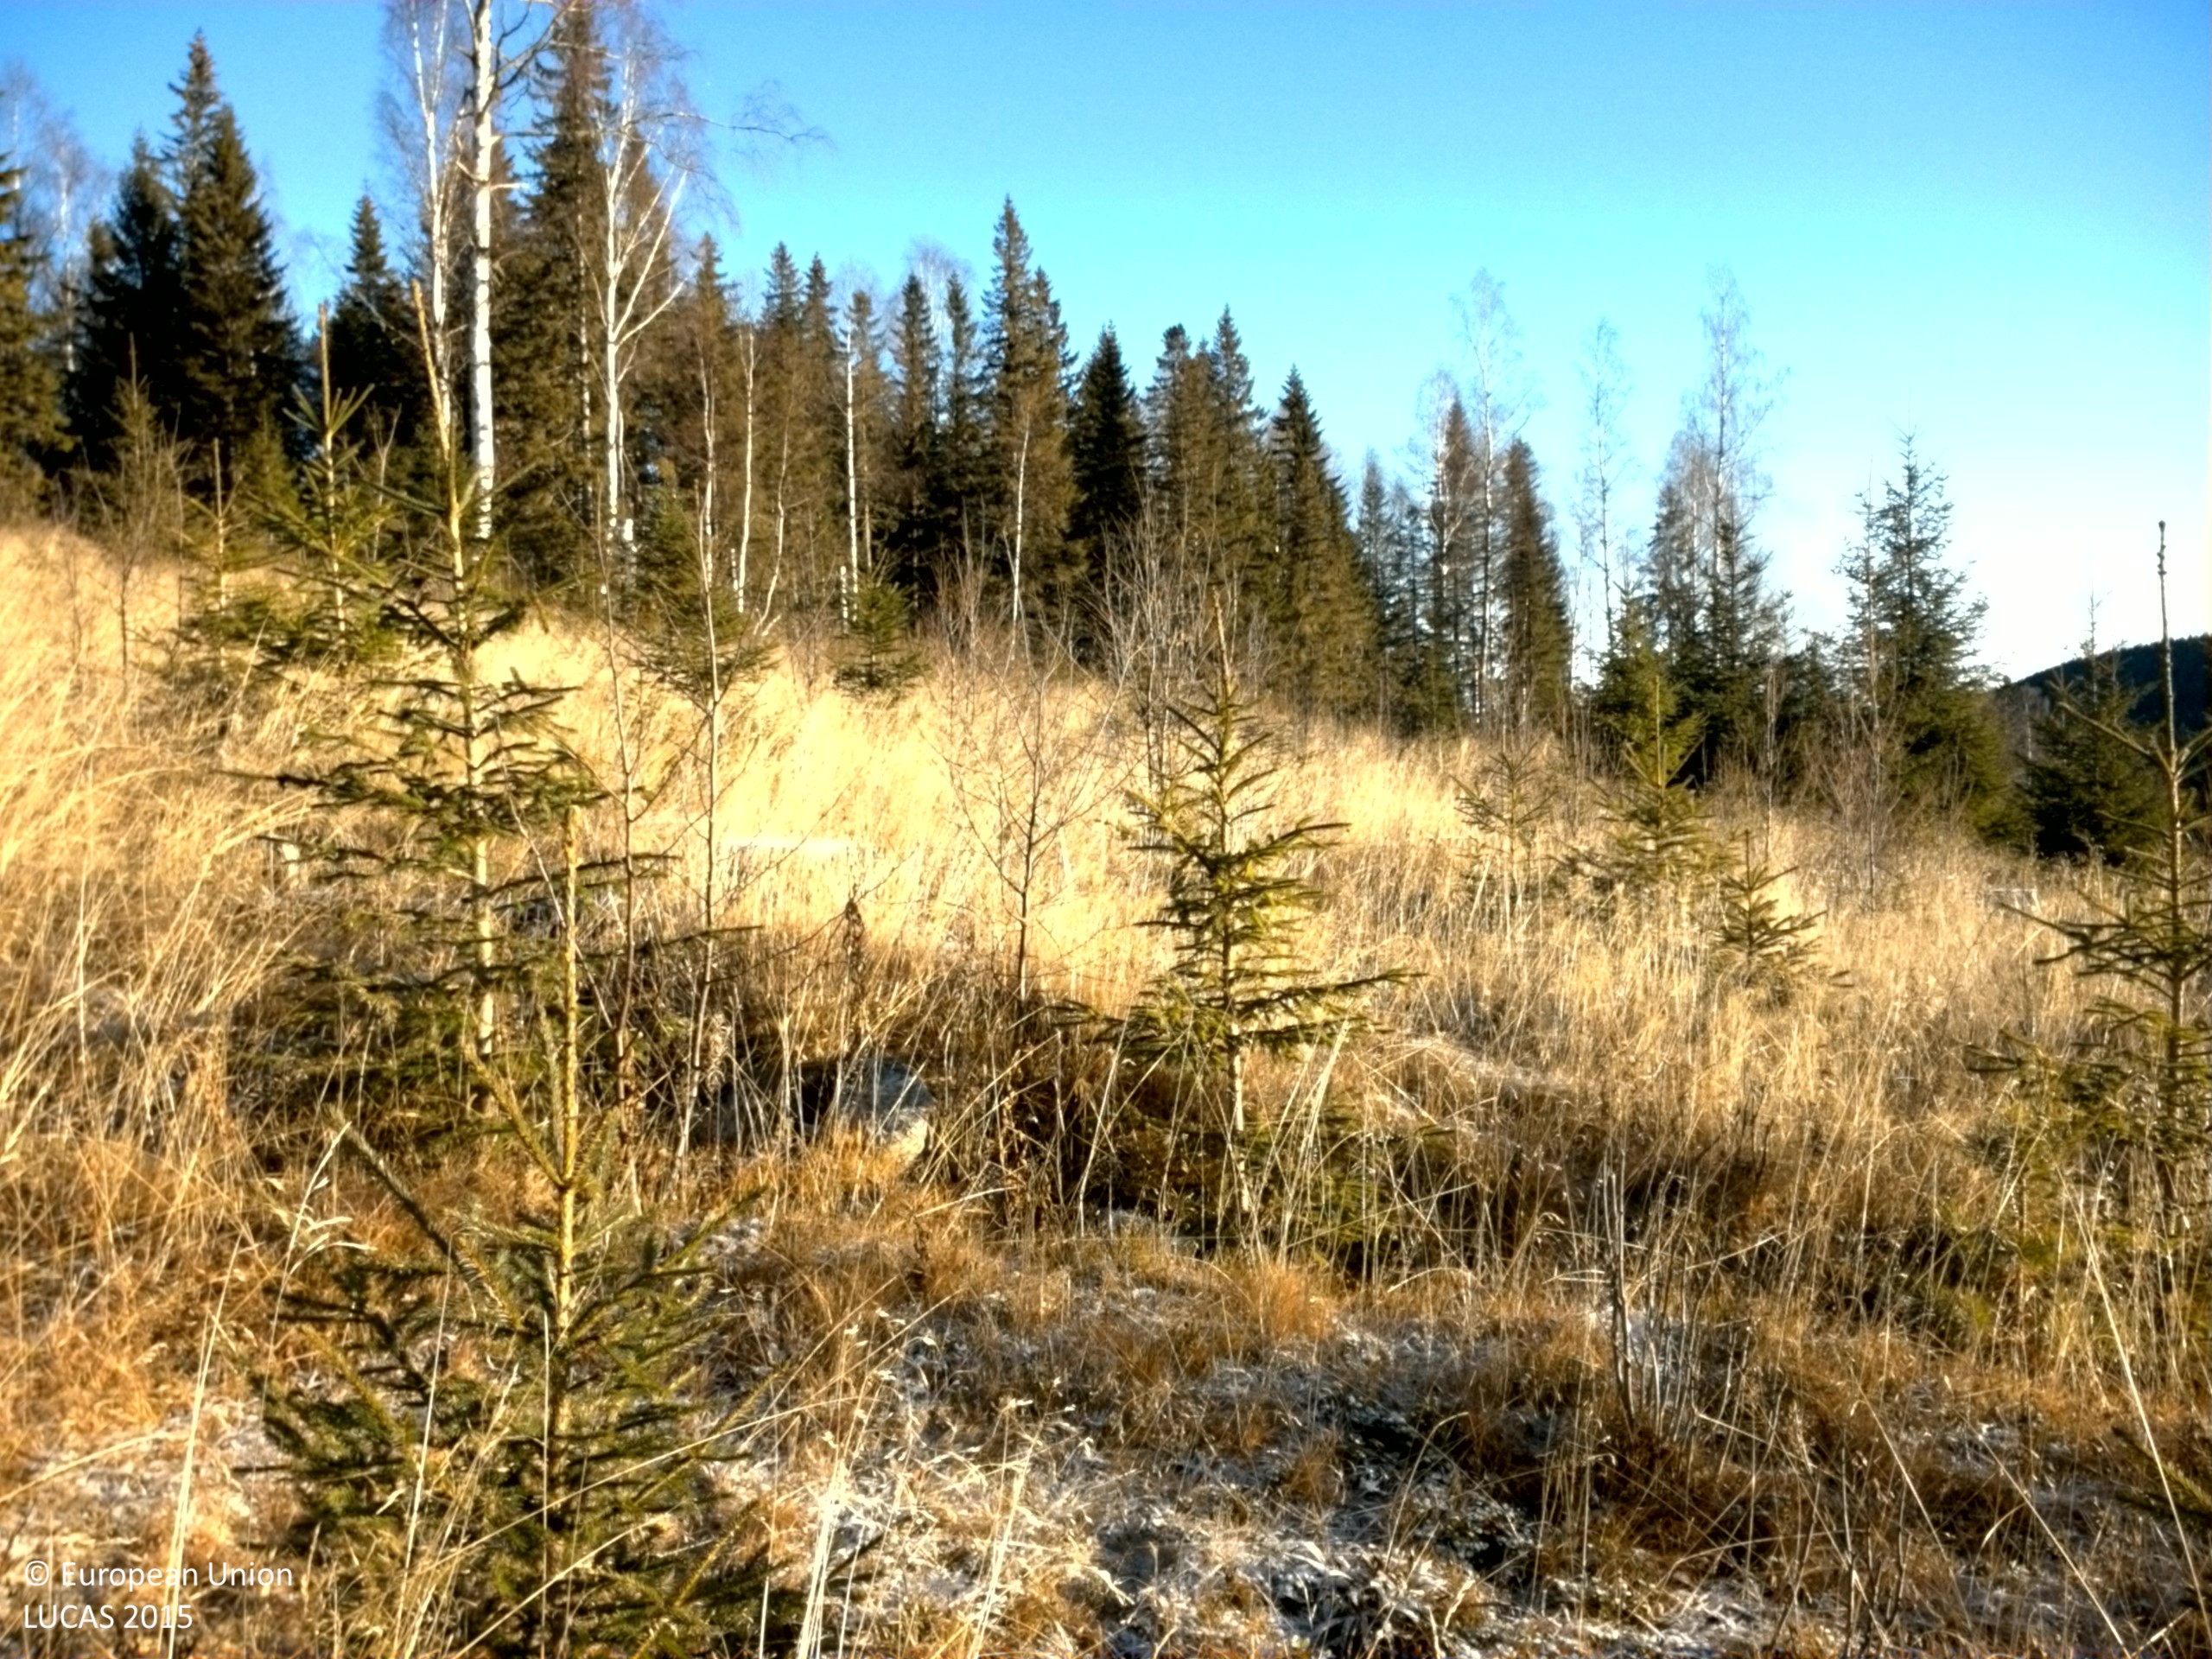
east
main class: Woodland
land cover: Spruce dominated mixed woodland
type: boreal forest
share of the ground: 25 - 50 %
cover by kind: herbaceous plants 50 %, coniferous forest trees 25 %, broadleaved forest trees 10 %, lichens and mosses 10 %, shrubs 5 %
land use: Forestry
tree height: < 5 m
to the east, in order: Spruce dominated mixed woodland; Spruce dominated coniferous woodland; Grassland with sparse tree/shrub cover; Spruce dominated mixed woodland
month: November
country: SE
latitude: 61.8877
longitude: 16.2029
